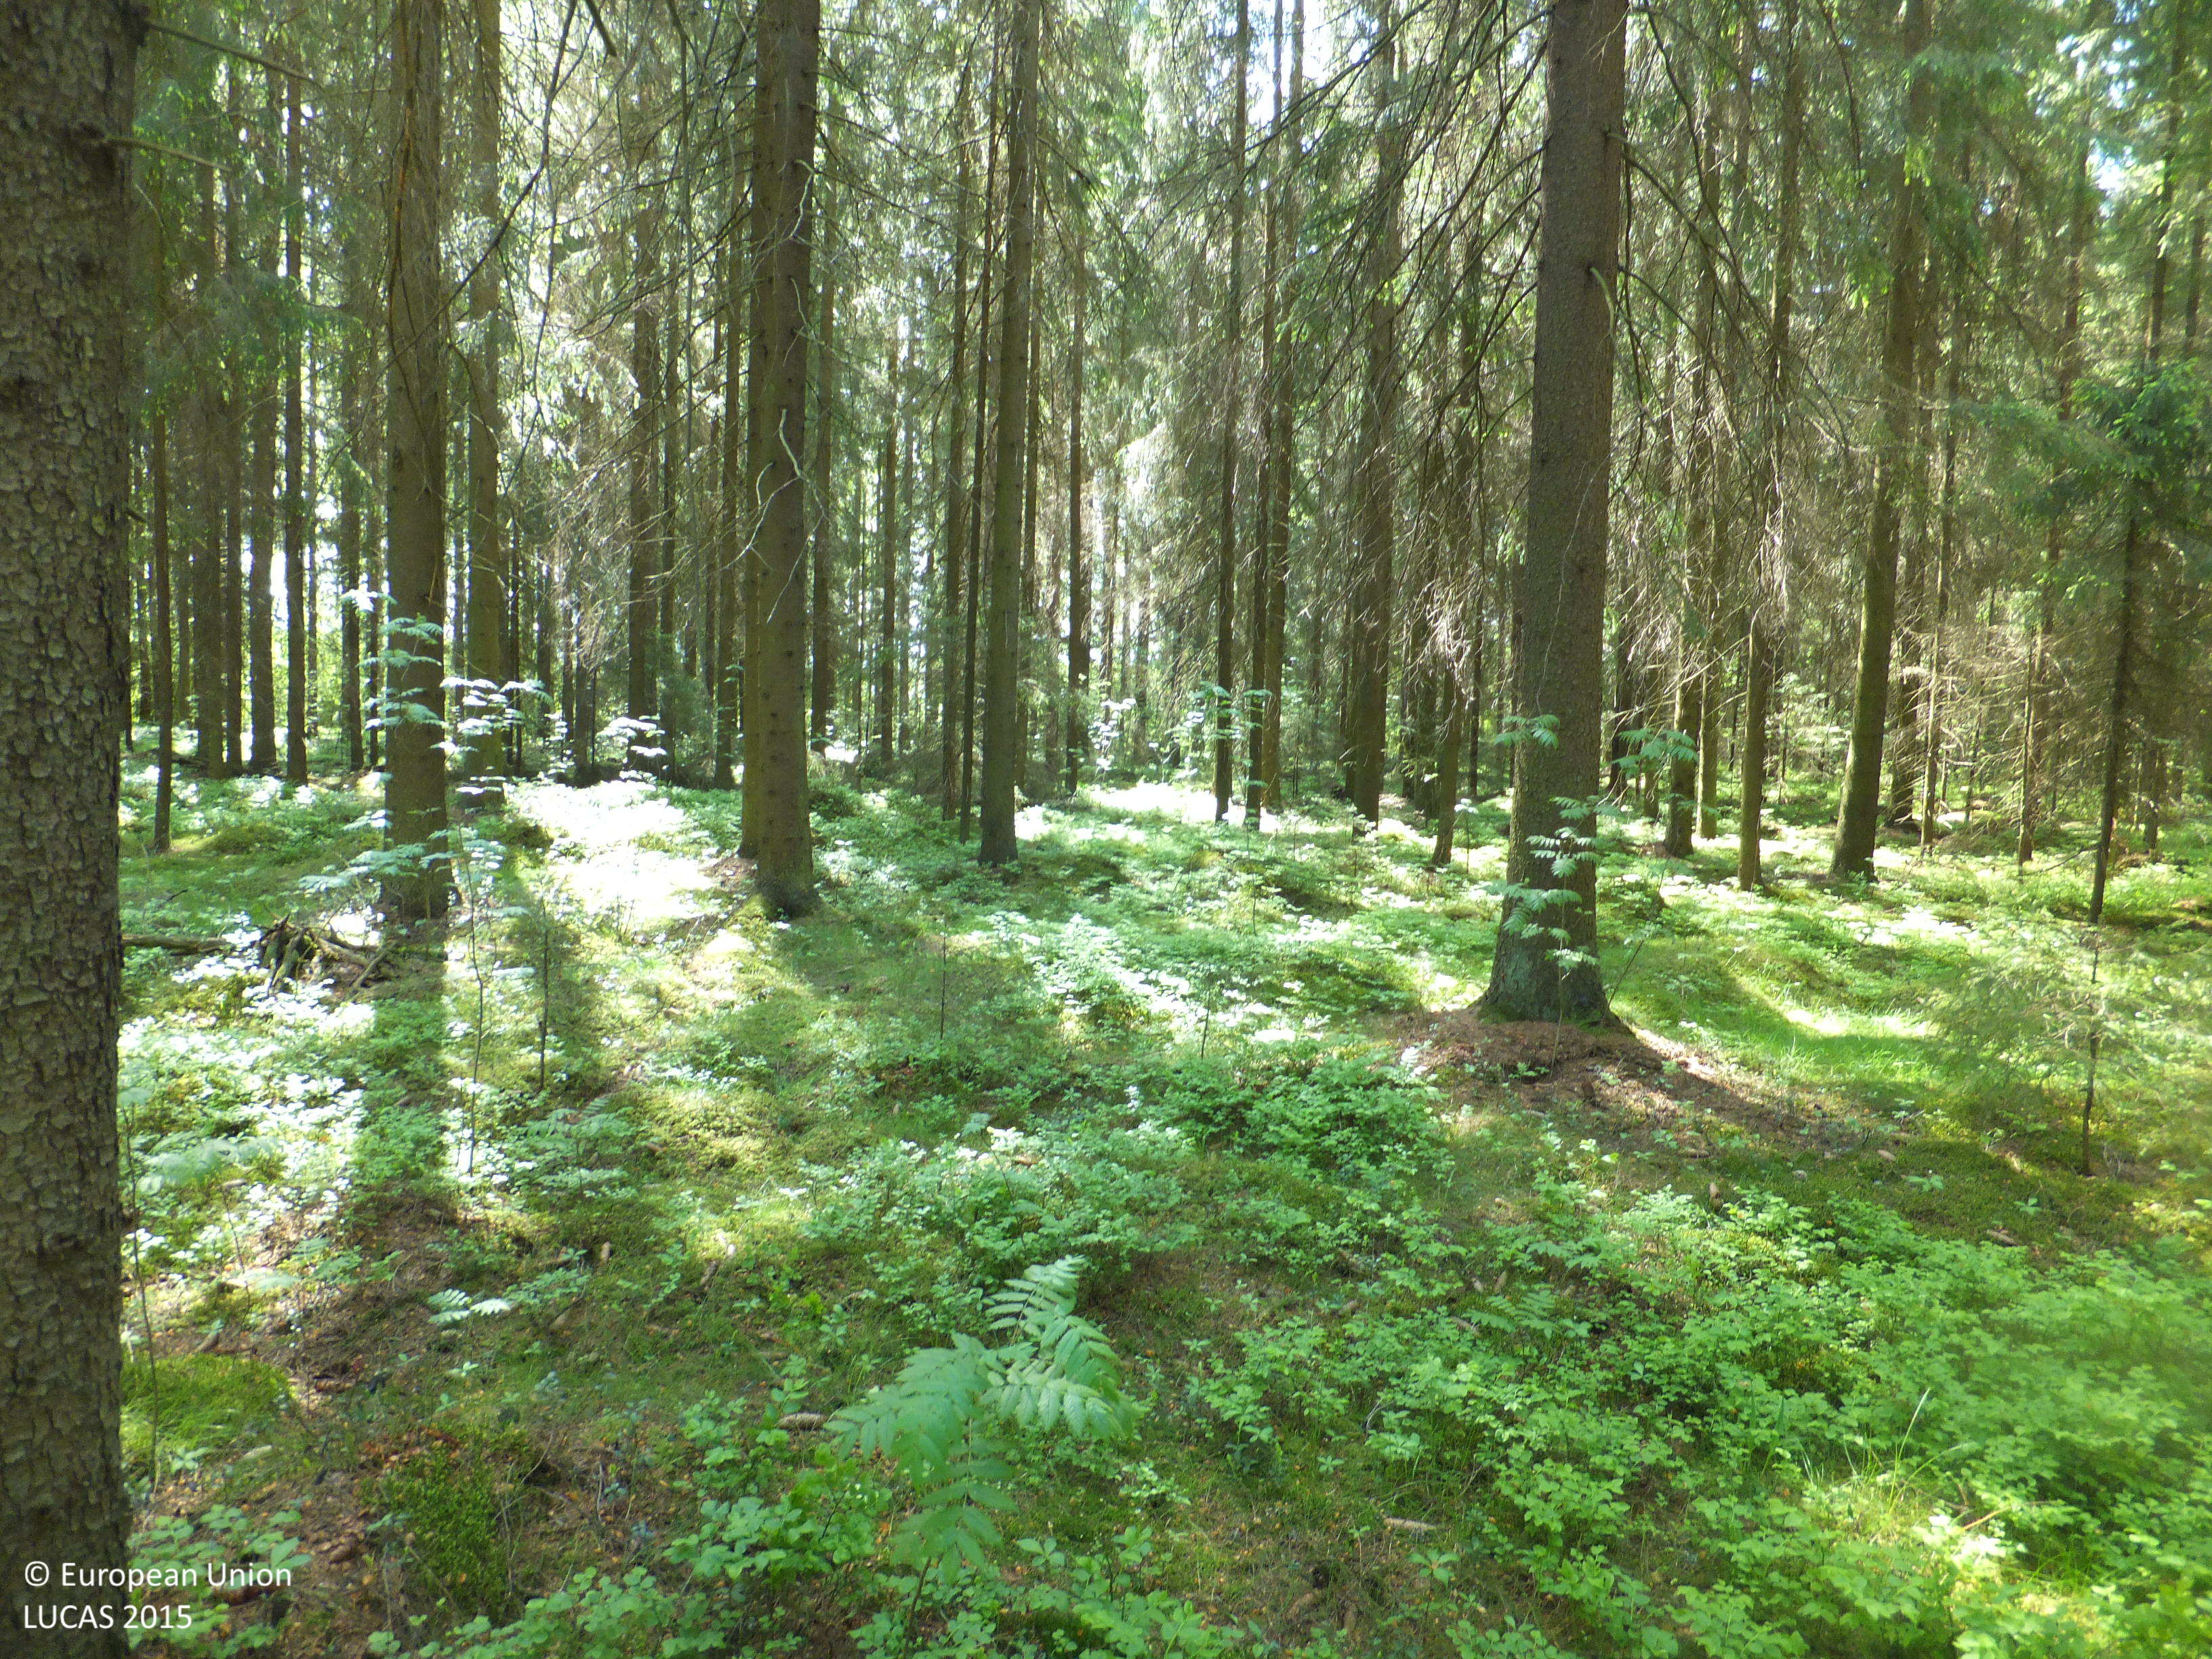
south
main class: Woodland
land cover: Spruce dominated coniferous woodland
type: boreal forest
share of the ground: > 75 %
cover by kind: coniferous forest trees 95 %, shrubs 5 %
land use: Forestry
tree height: > 5 m
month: June
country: FI
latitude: 63.3458
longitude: 22.5772
